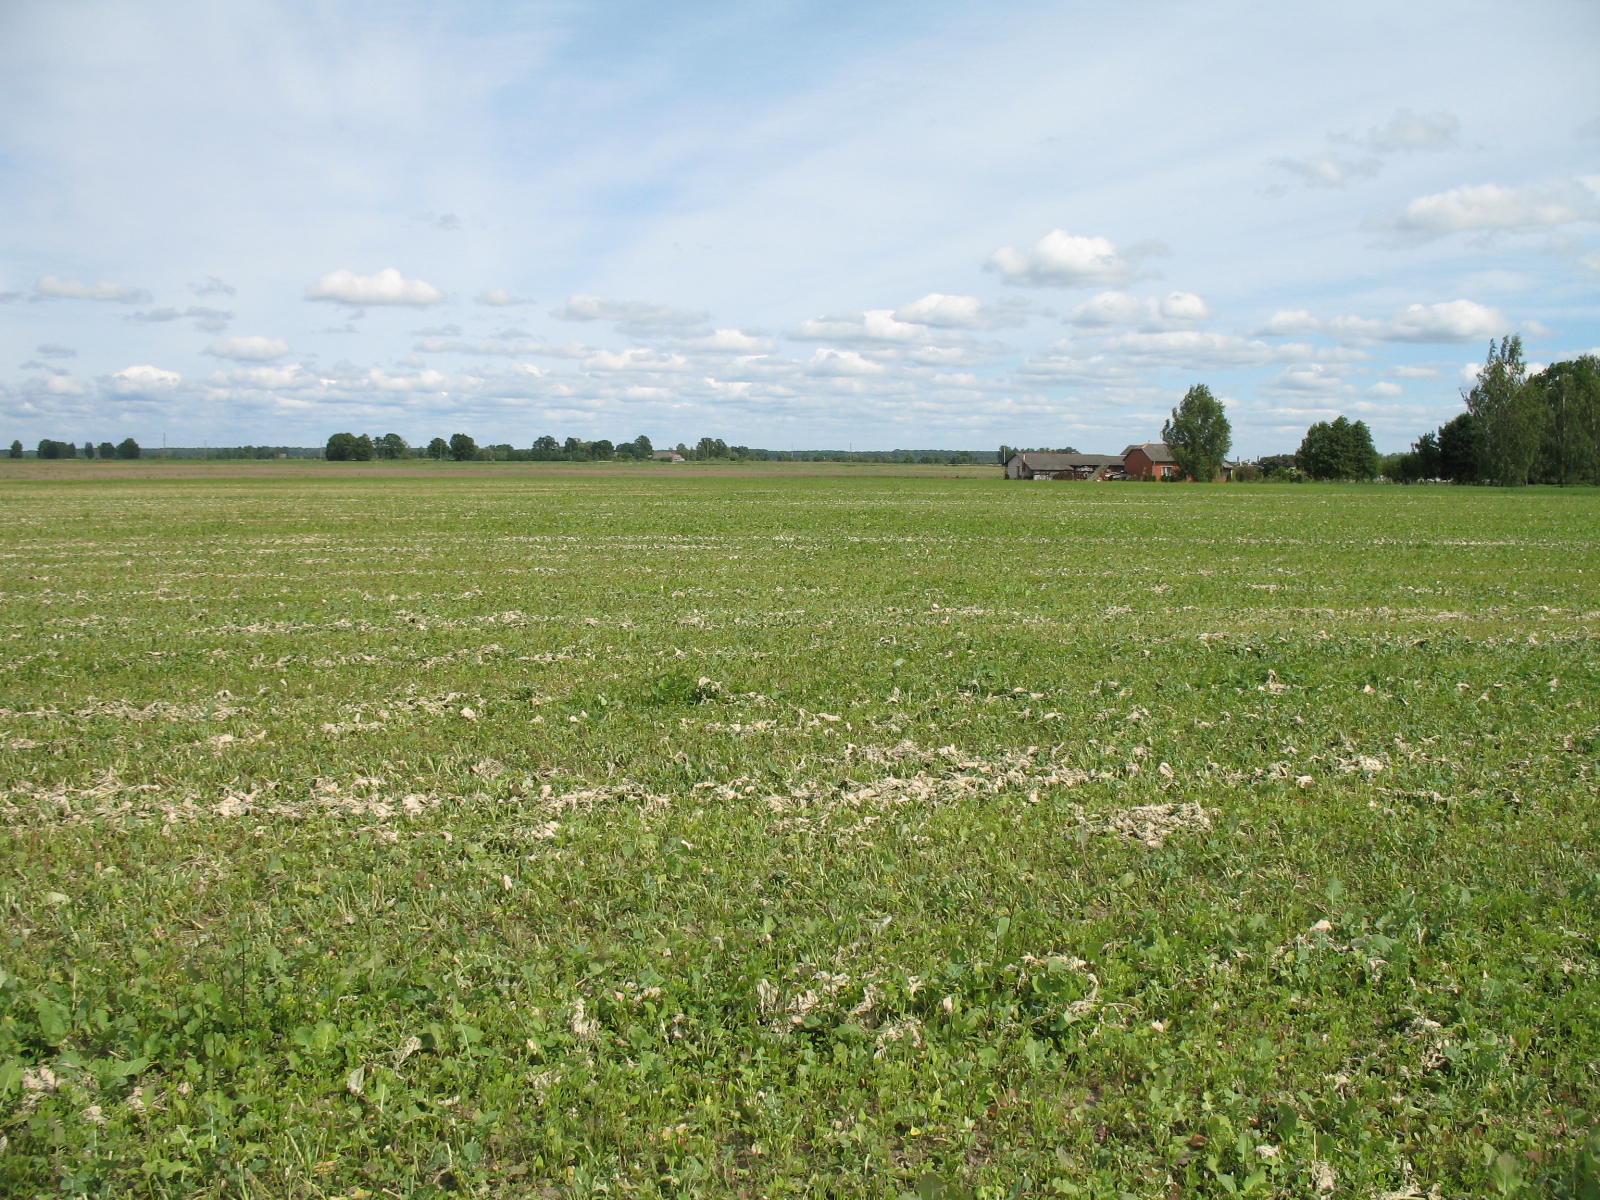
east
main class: Cropland
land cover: Rape and turnip rape
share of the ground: > 75 %
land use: Agriculture (excluding fallow land and kitchen gardens)
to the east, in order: Rape and turnip rape; Grass margins; Ditches and canals; Grass margins; Other bare soil; Maize
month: June
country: LV
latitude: 56.6428
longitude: 23.4615
